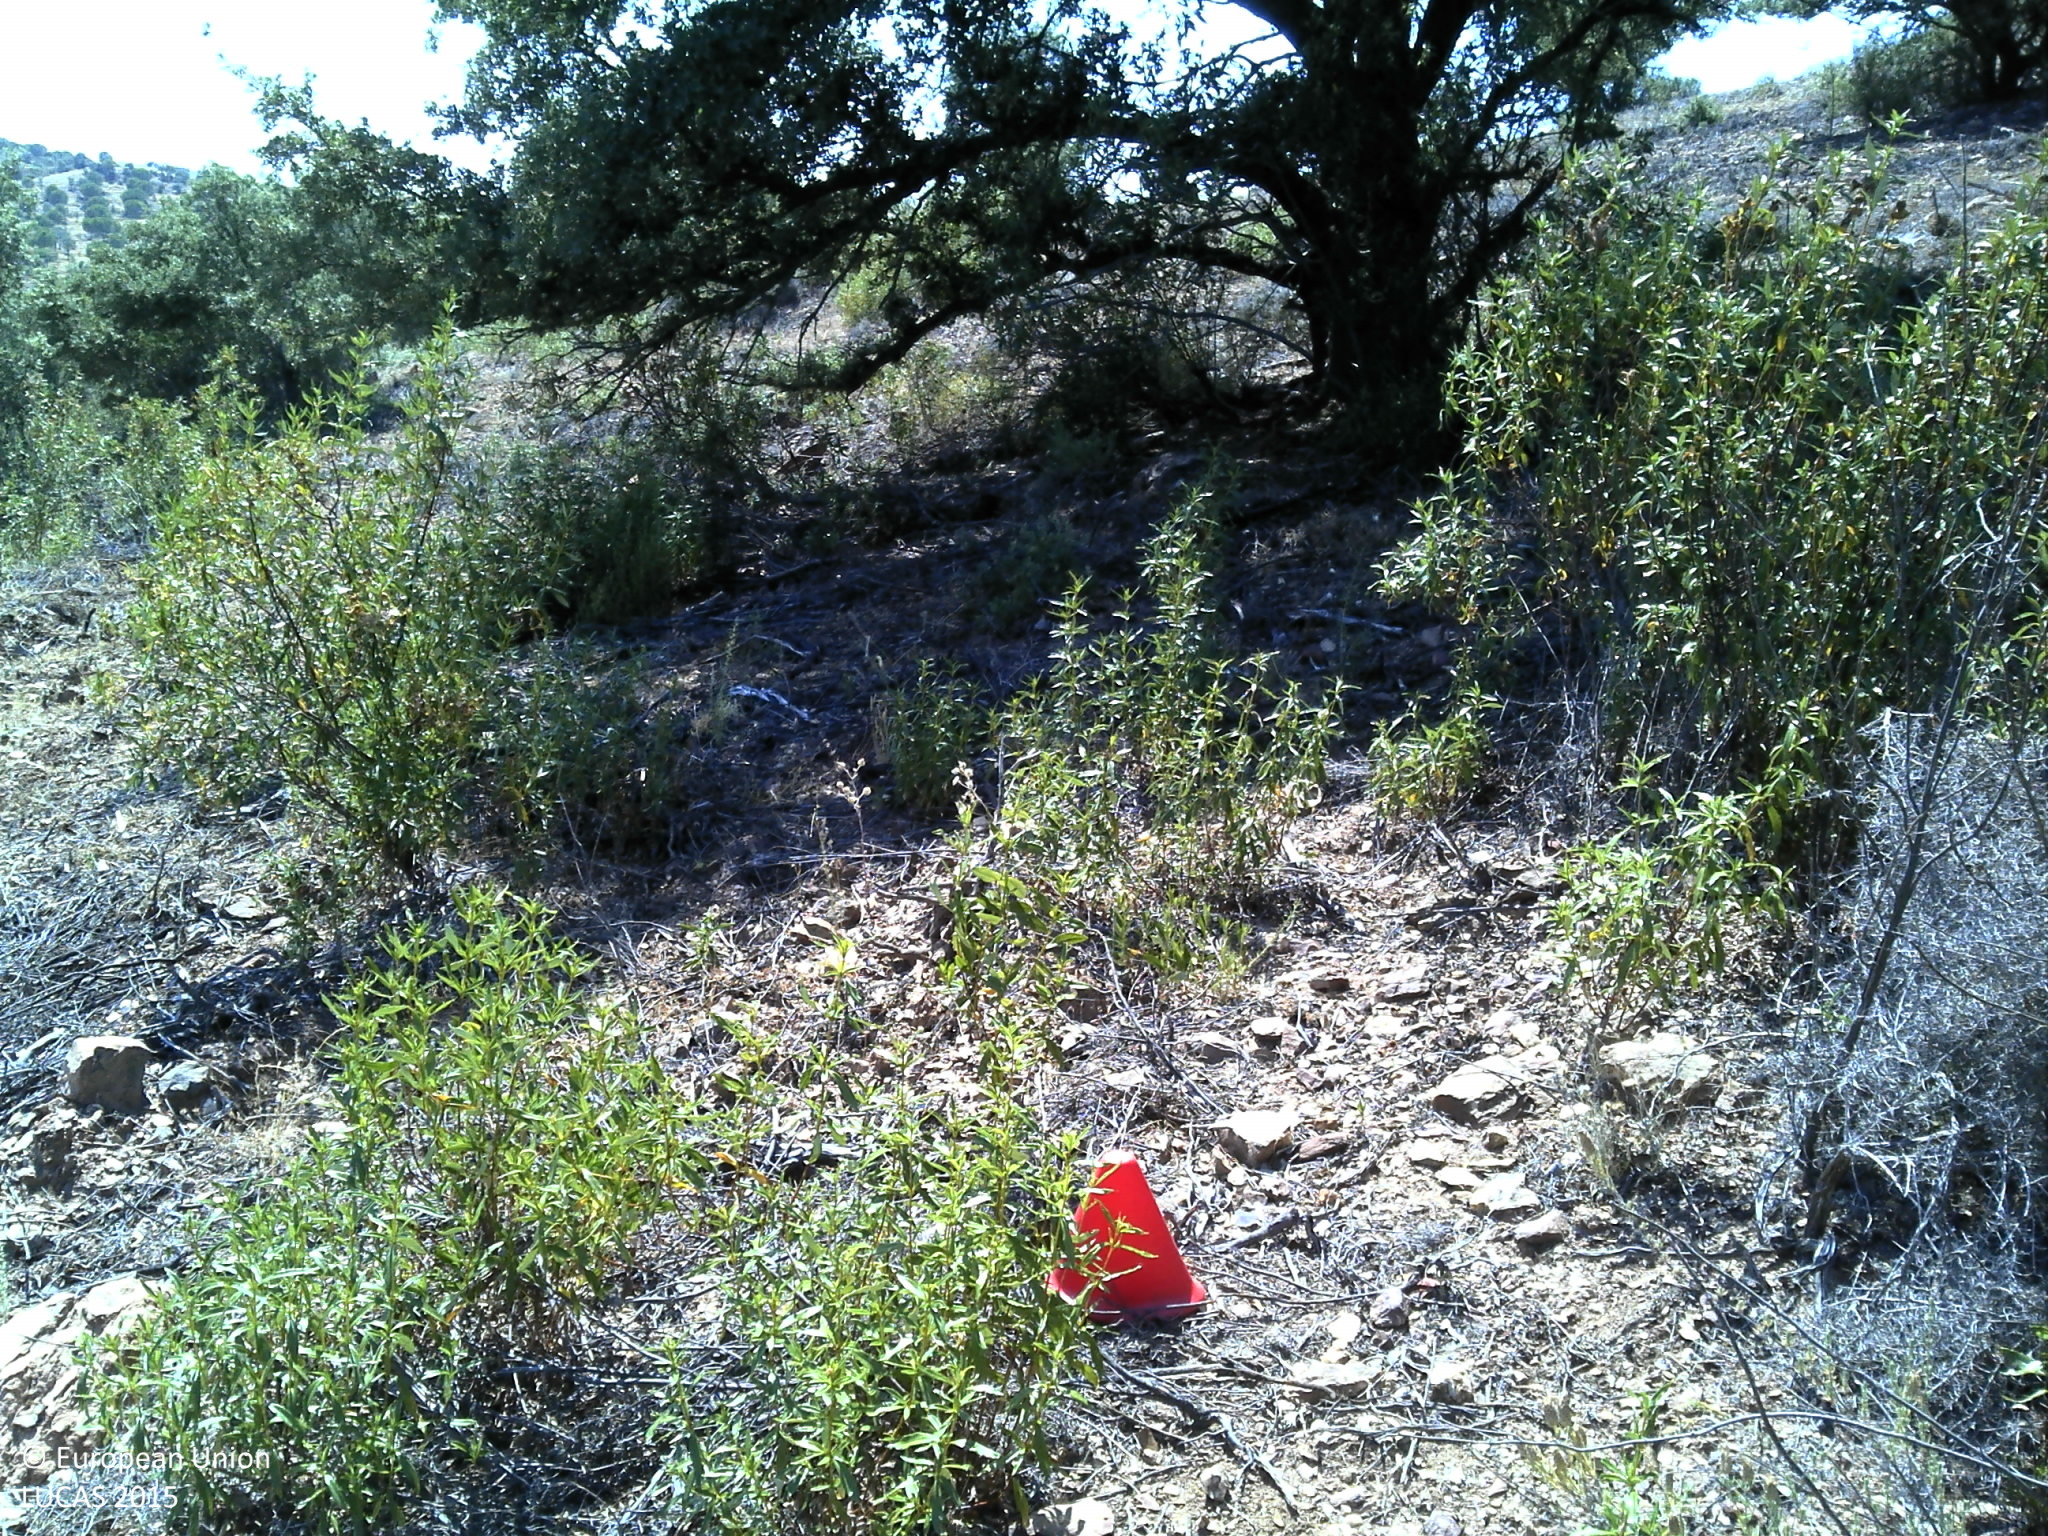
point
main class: Shrubland
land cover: Shrubland with sparse tree cover
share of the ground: 10 - 25 %
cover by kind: unconsolidated bare surface 60 %, shrubs 20 %, herbaceous plants 15 %, broadleaved forest trees 5 %
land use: Agriculture (excluding fallow land and kitchen gardens)
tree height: > 5 m
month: June
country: PT
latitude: 37.6501
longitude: -7.4779
